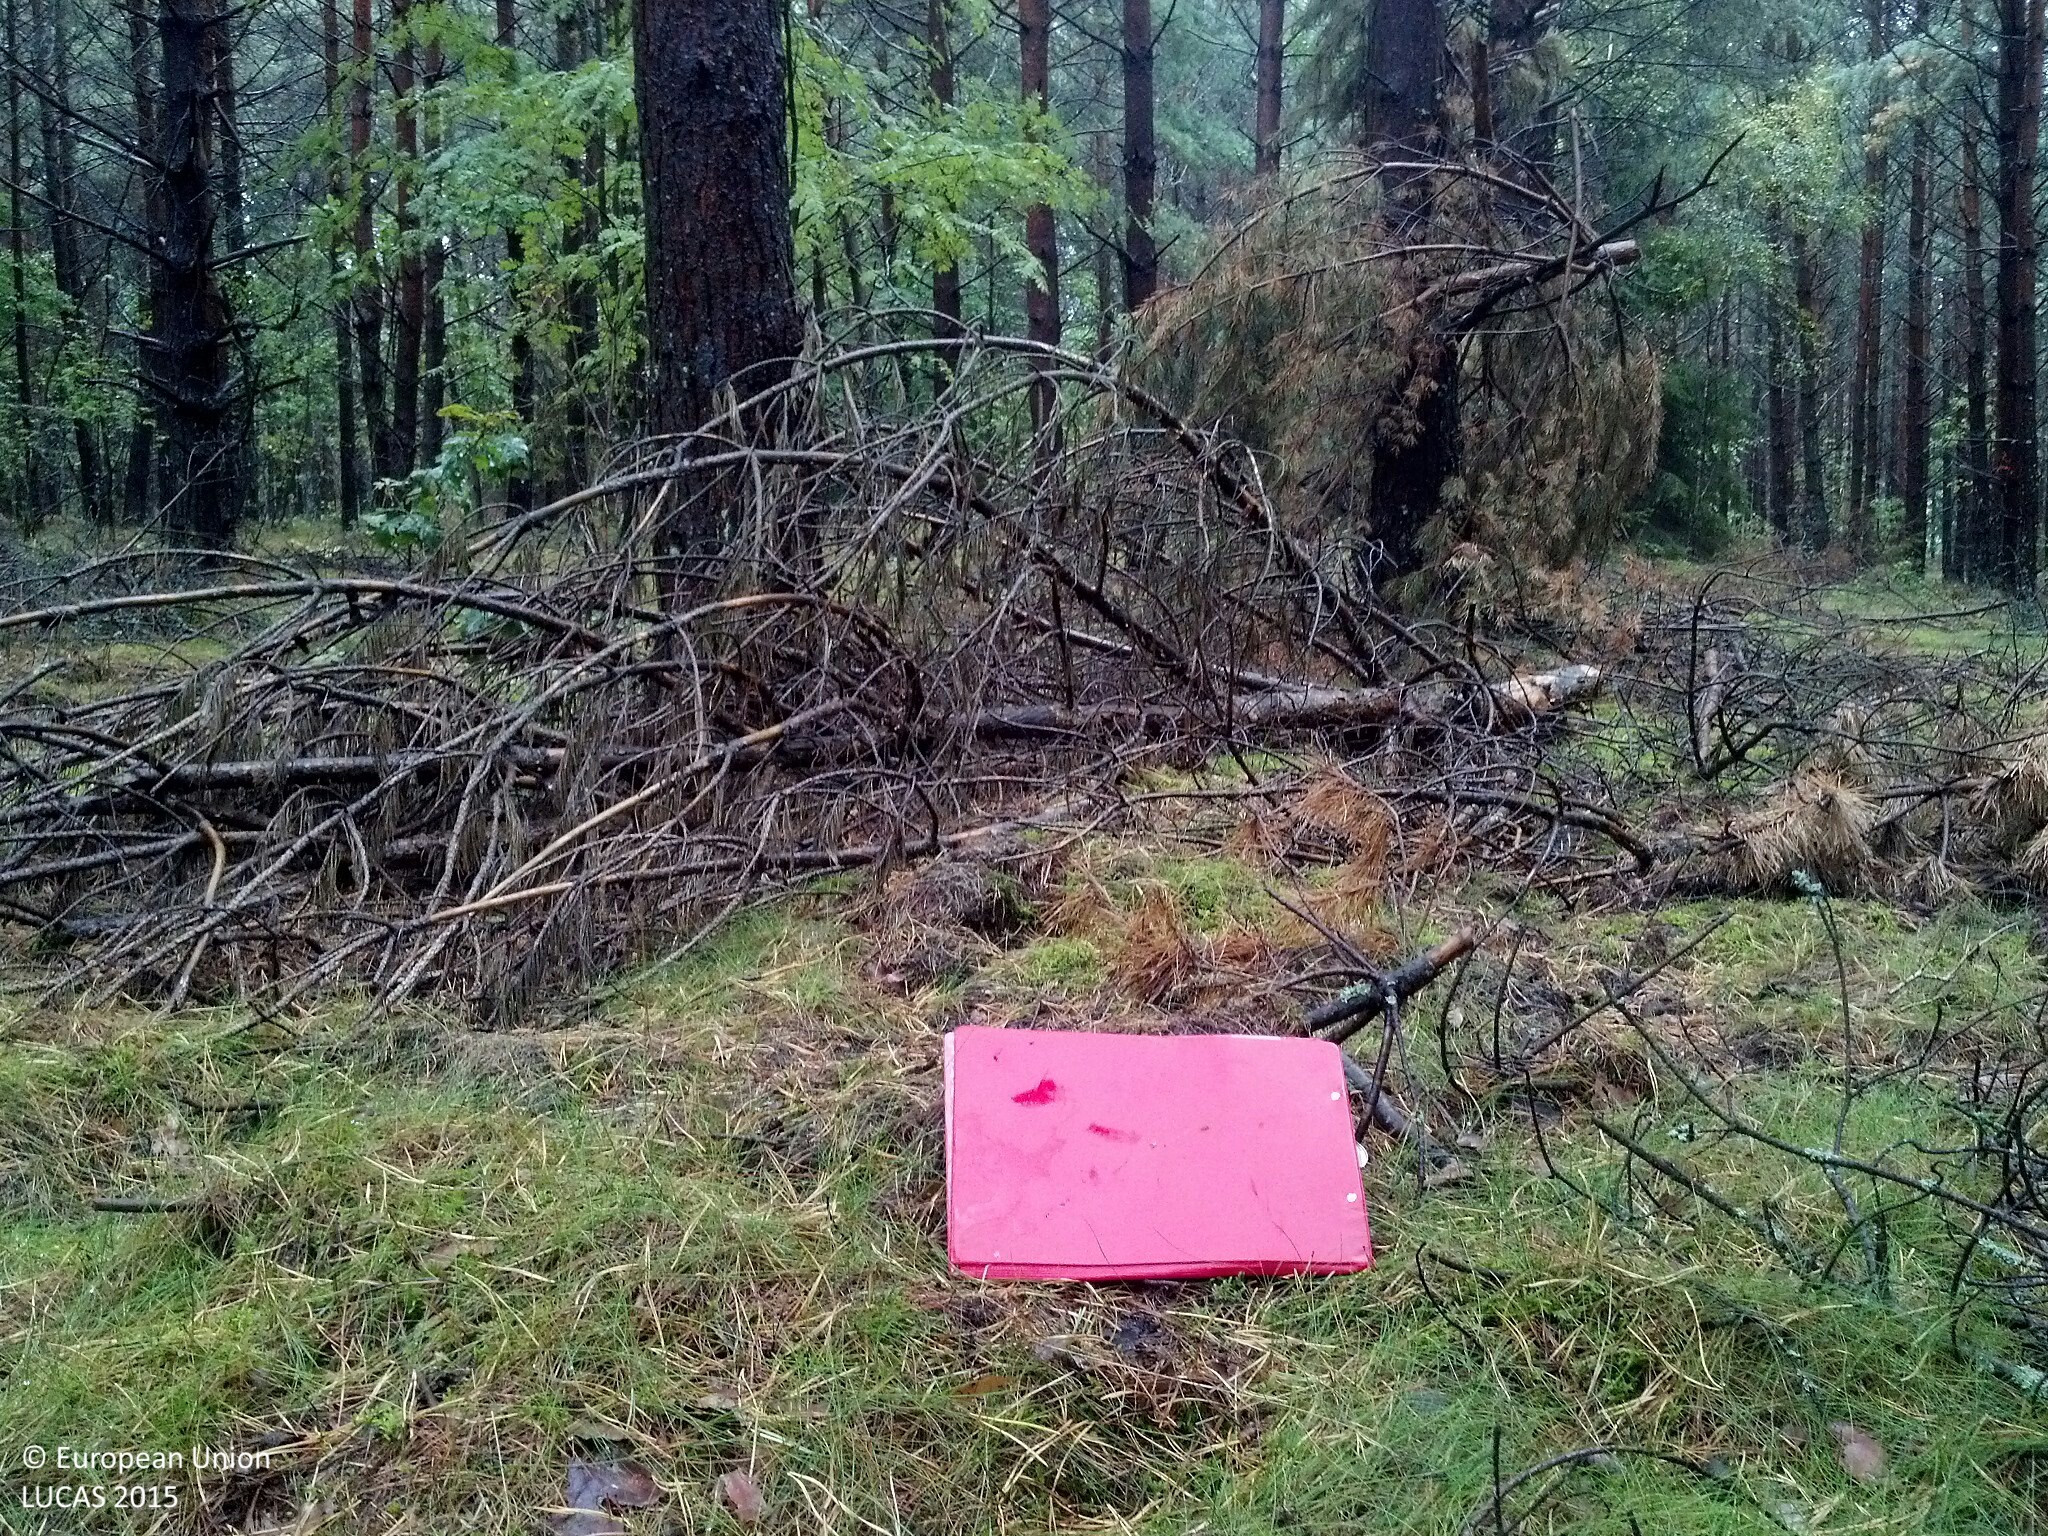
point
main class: Woodland
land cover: Pine dominated coniferous woodland
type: hemiboreal forest and nemoral coniferous forest and mixed broadleaved-coniferous forest
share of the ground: > 75 %
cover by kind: coniferous forest trees 85 %, broadleaved forest trees 5 %, herbaceous plants 5 %, lichens and mosses 5 %
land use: Forestry
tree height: > 5 m
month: September
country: PL
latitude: 54.5341
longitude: 17.9099
